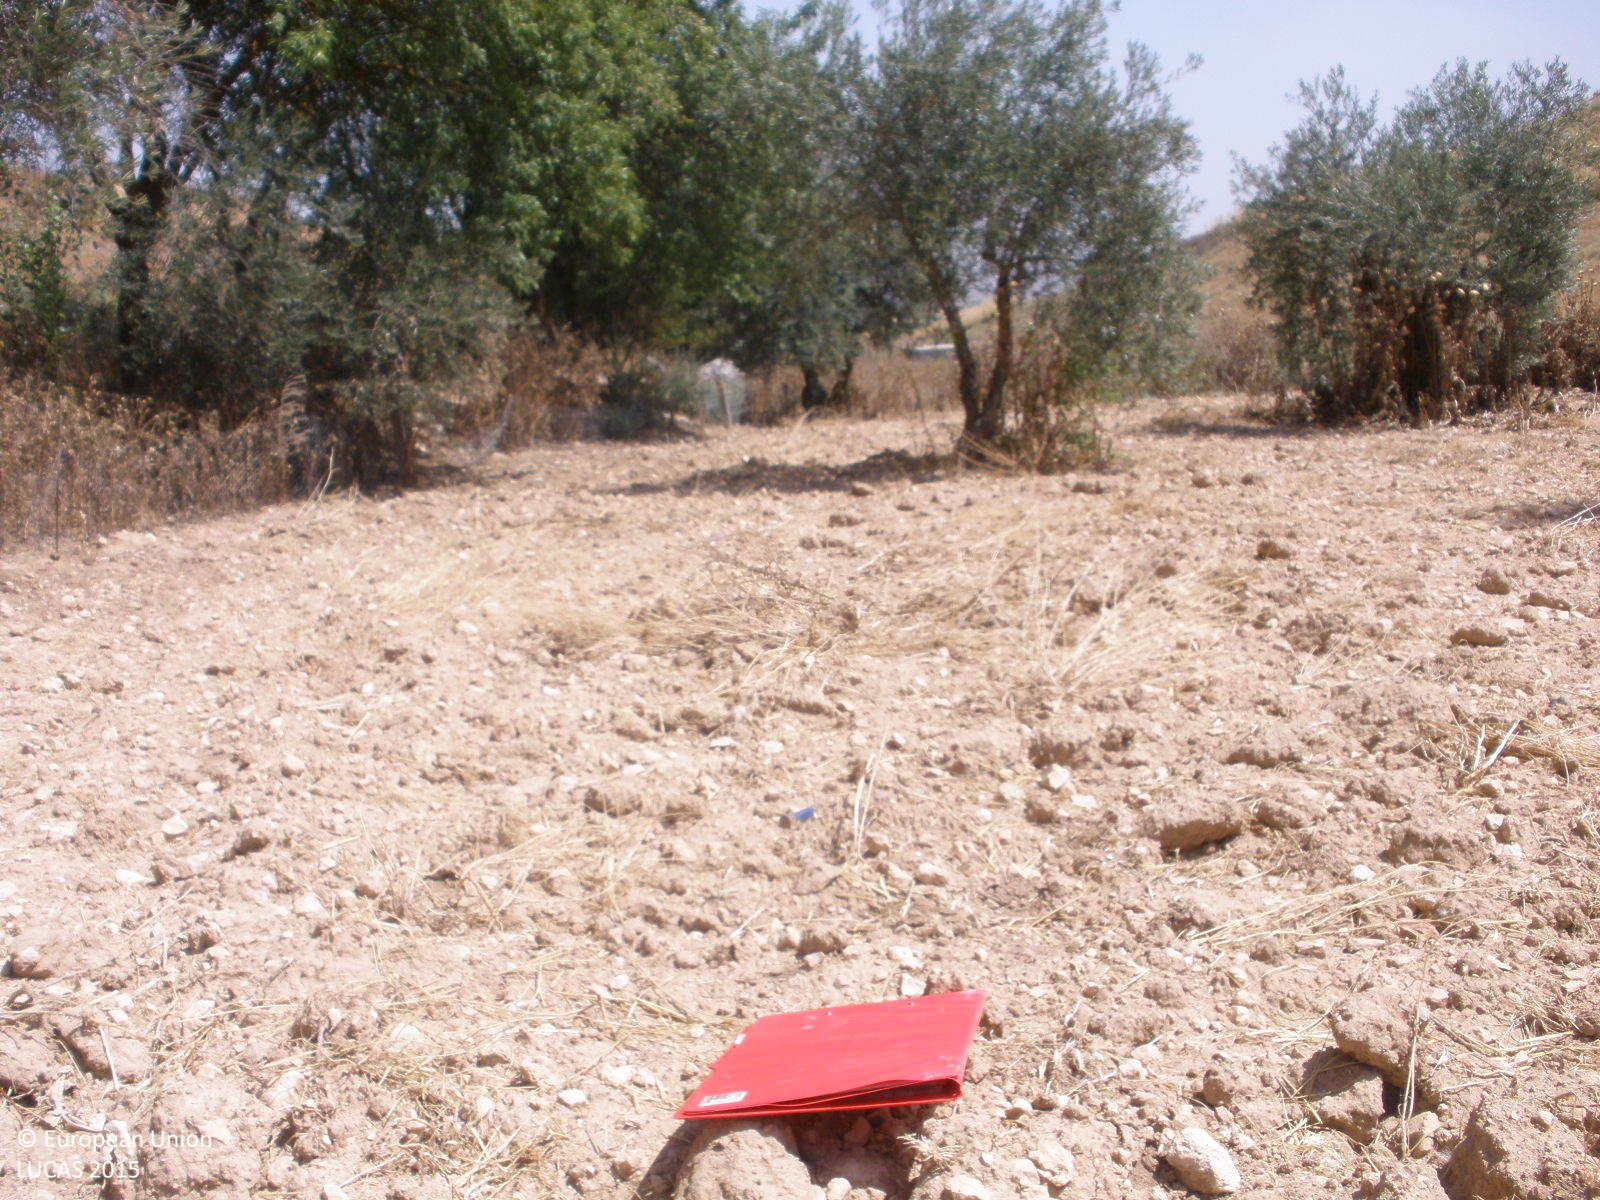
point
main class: Cropland
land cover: Olive groves
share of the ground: 25 - 50 %
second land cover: Other bare soil
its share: > 75 %
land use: Agriculture (excluding fallow land and kitchen gardens)
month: July
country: ES
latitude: 39.9909
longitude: -3.4859
